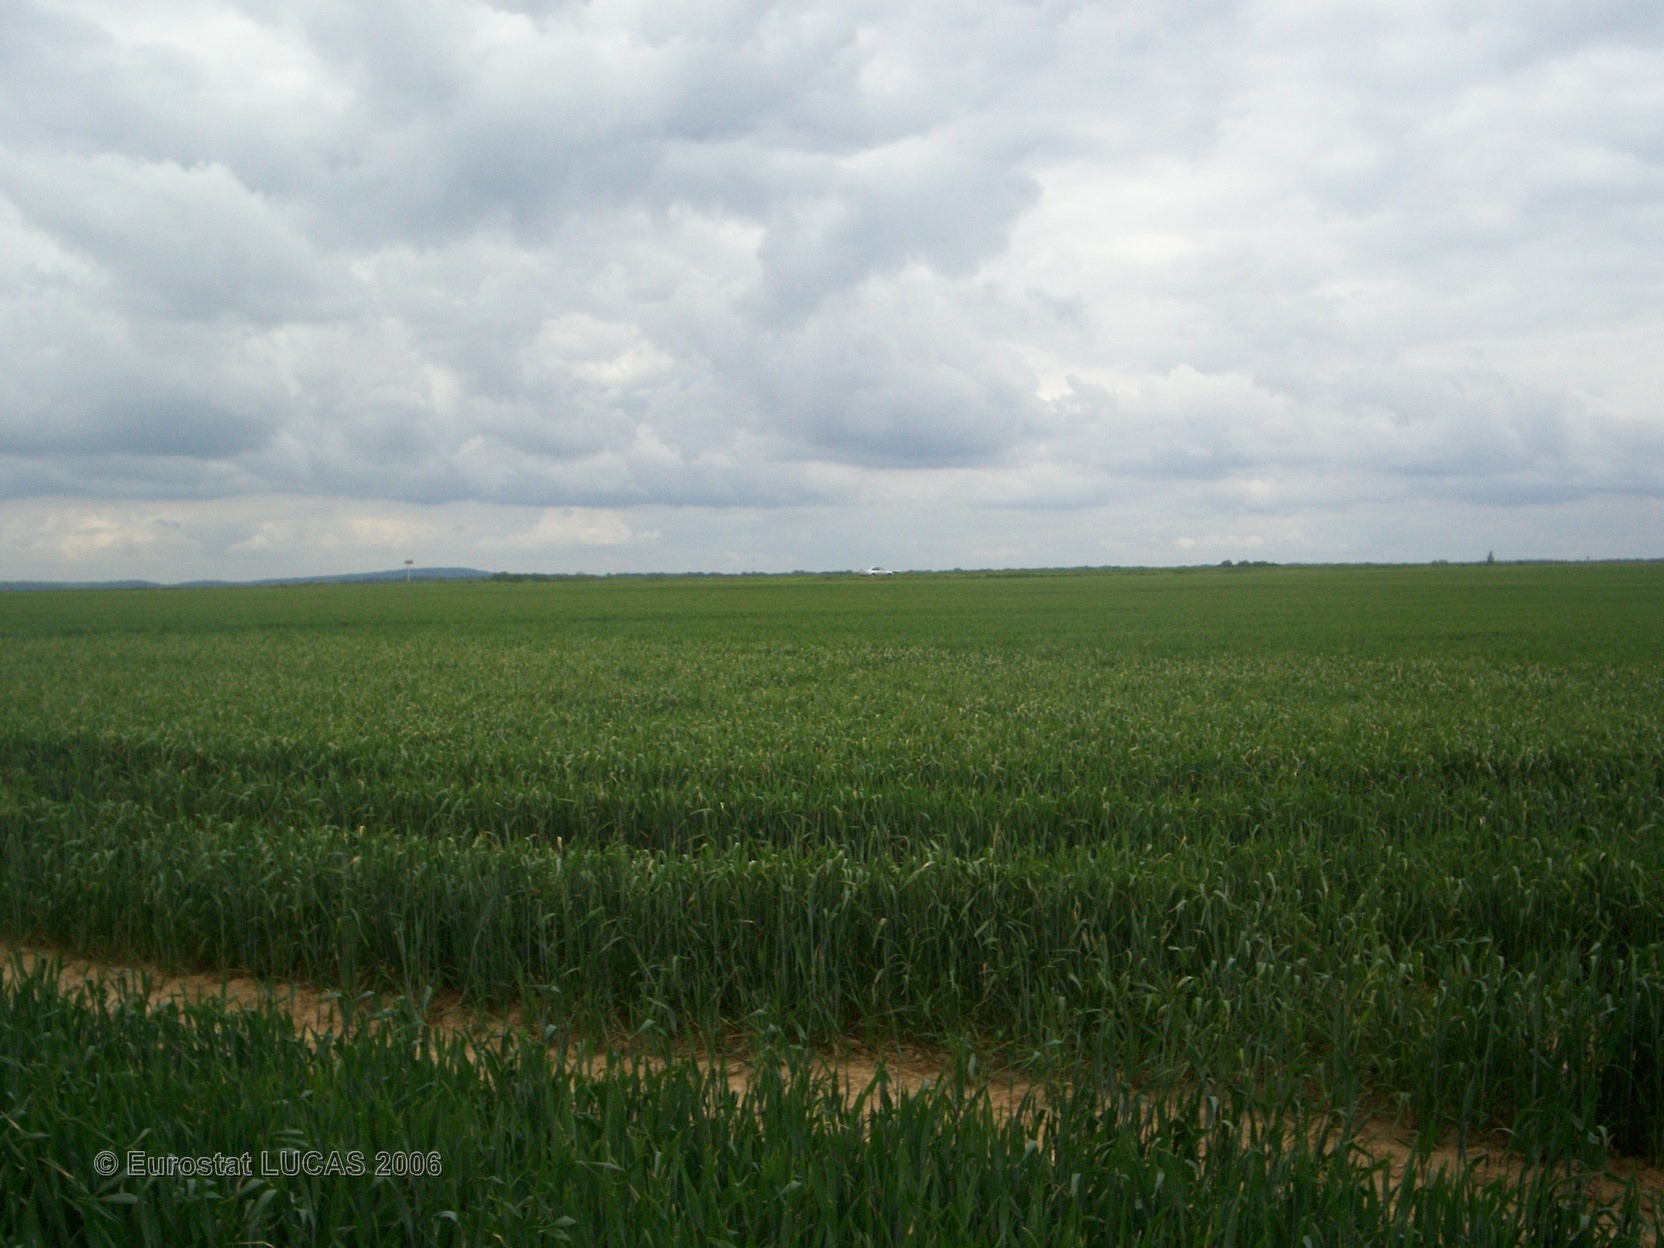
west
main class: Cropland
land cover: Common wheat
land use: Agriculture (excluding fallow land and kitchen gardens)
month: May
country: FR
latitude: 49.1203
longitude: 2.7138
